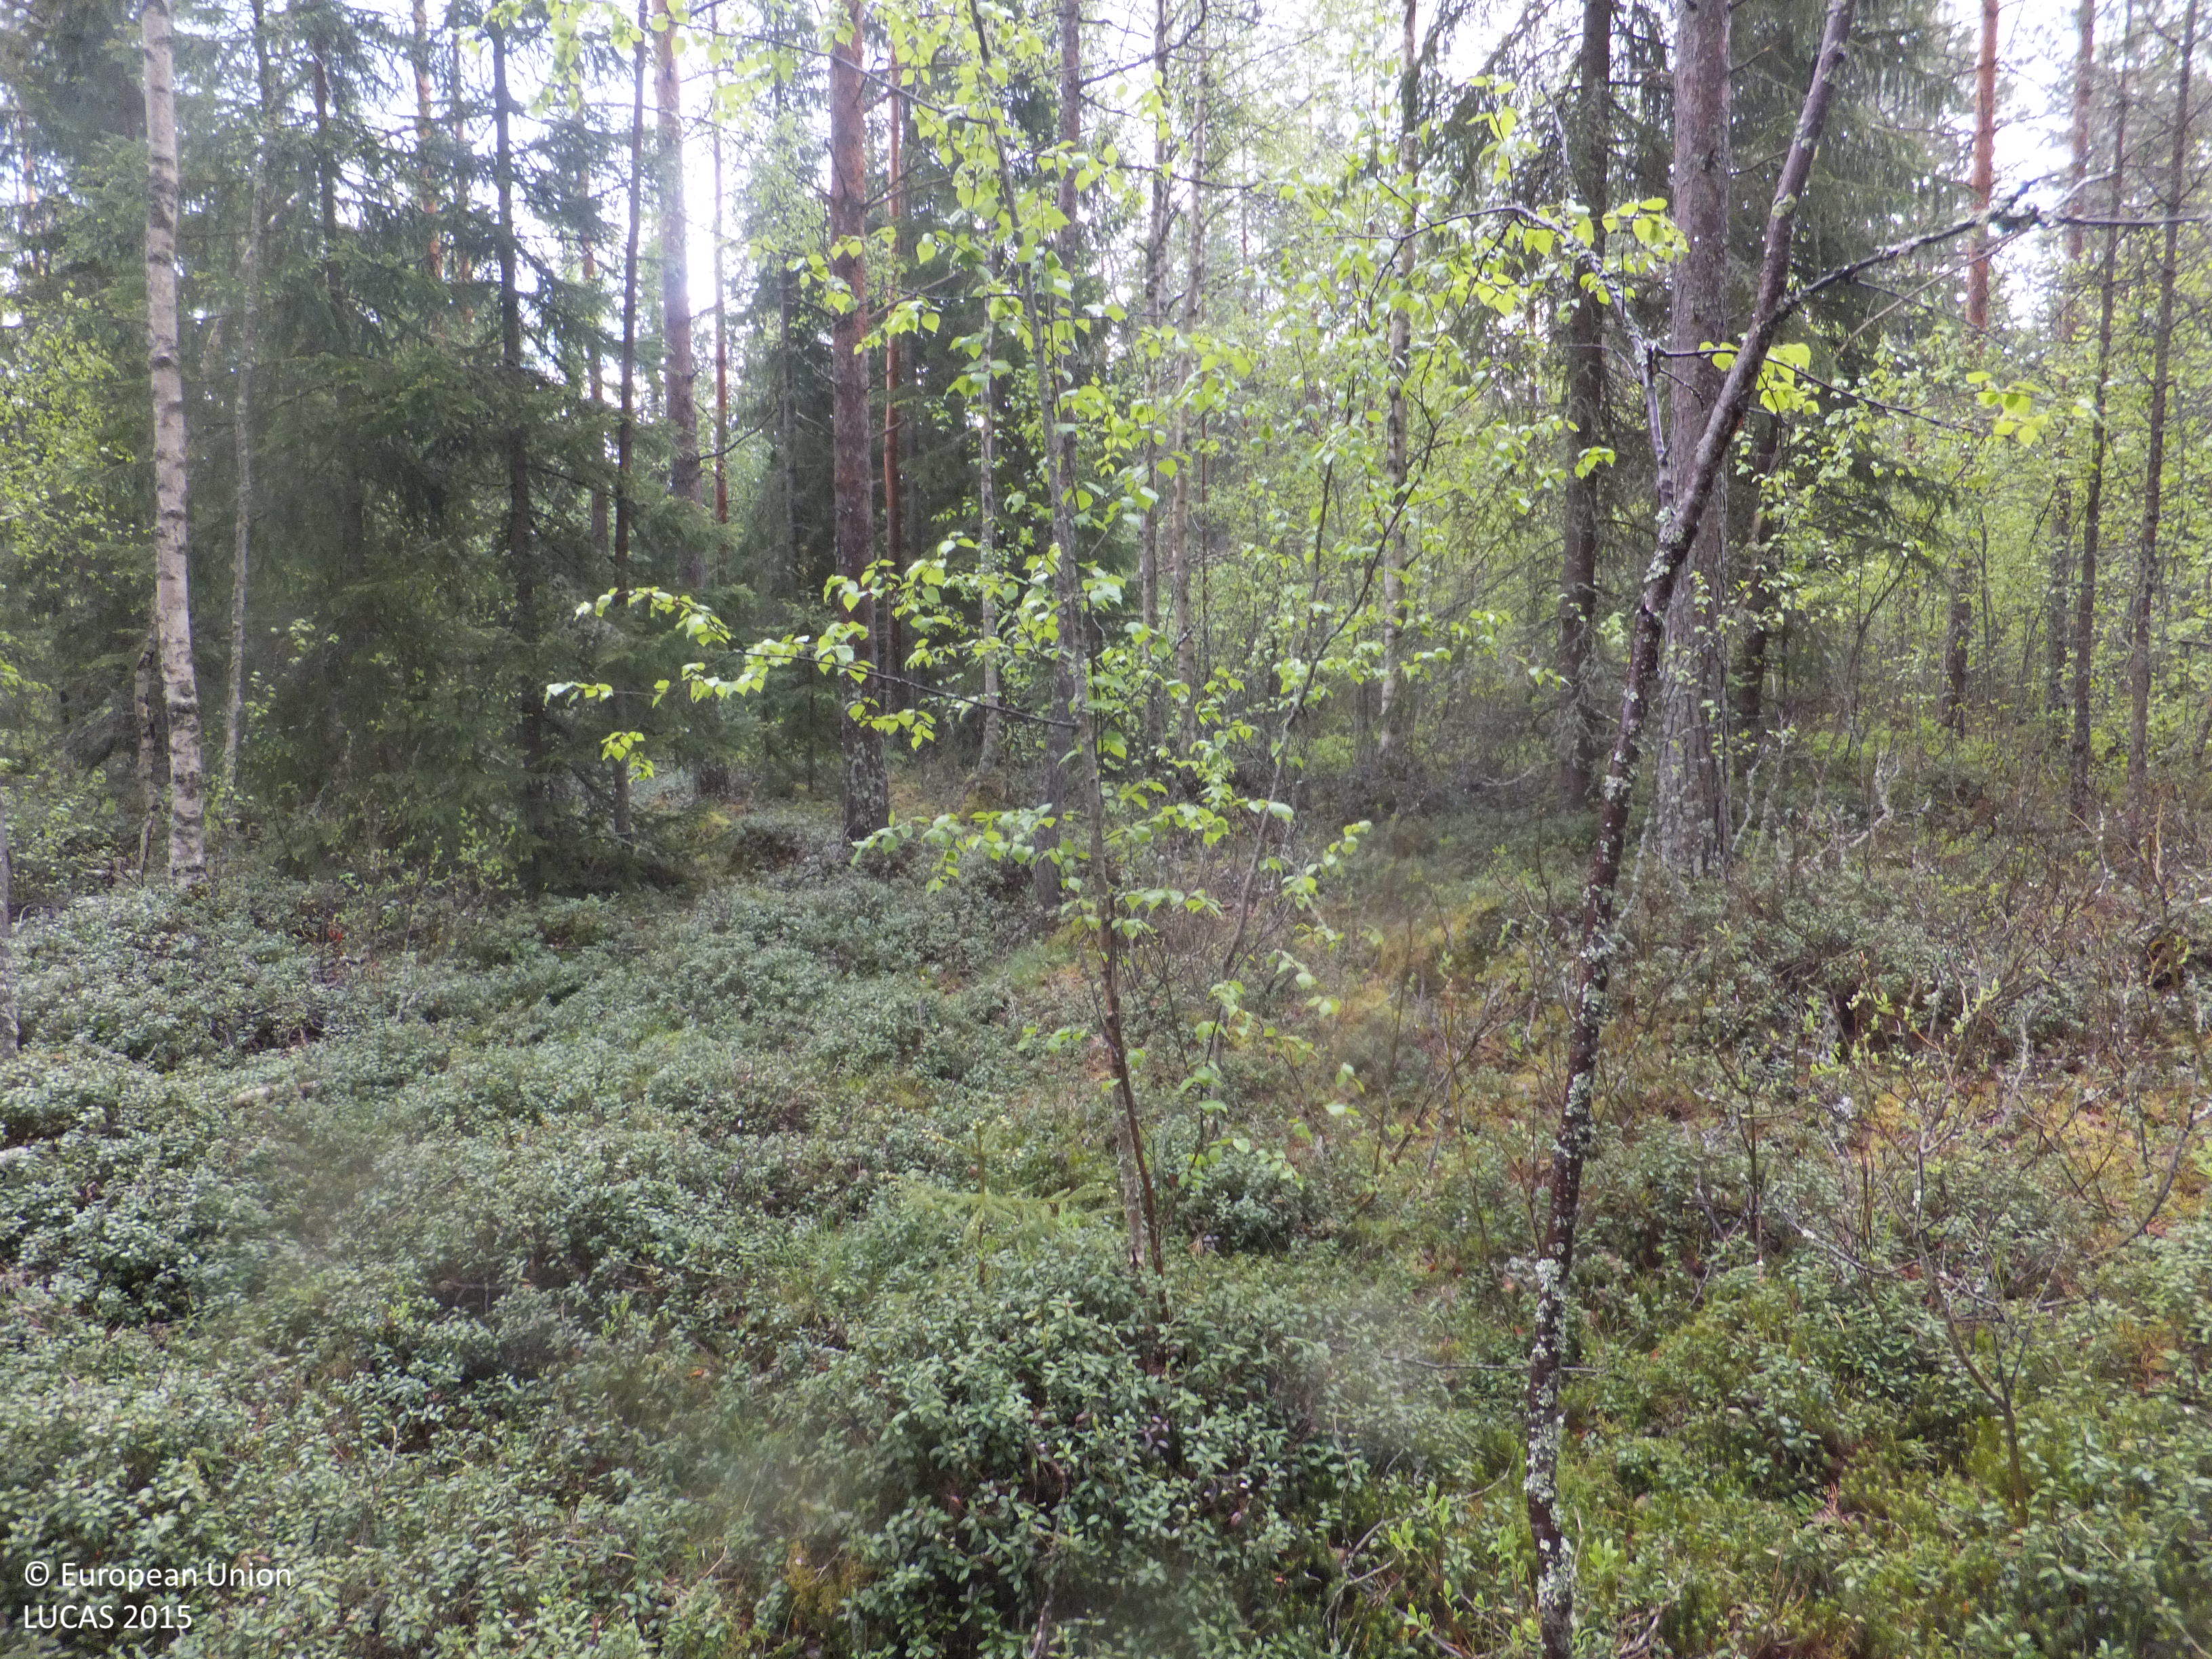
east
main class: Woodland
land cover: Pine dominated mixed woodland
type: boreal forest
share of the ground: > 75 %
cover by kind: coniferous forest trees 60 %, broadleaved forest trees 30 %, shrubs 5 %, lichens and mosses 5 %
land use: Forestry
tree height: > 5 m
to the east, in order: Pine dominated mixed woodland; Ditches and canals; Pine dominated coniferous woodland; Ditches and canals; Pine dominated coniferous woodland; Ditches and canals; Pine dominated coniferous woodland; Ditches and canals; Pine dominated coniferous woodland; Ditches and canals; Pine dominated coniferous woodland; Ditches and canals; Pine dominated coniferous woodland; Ditches and canals
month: June
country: FI
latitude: 63.3881
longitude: 23.1640
